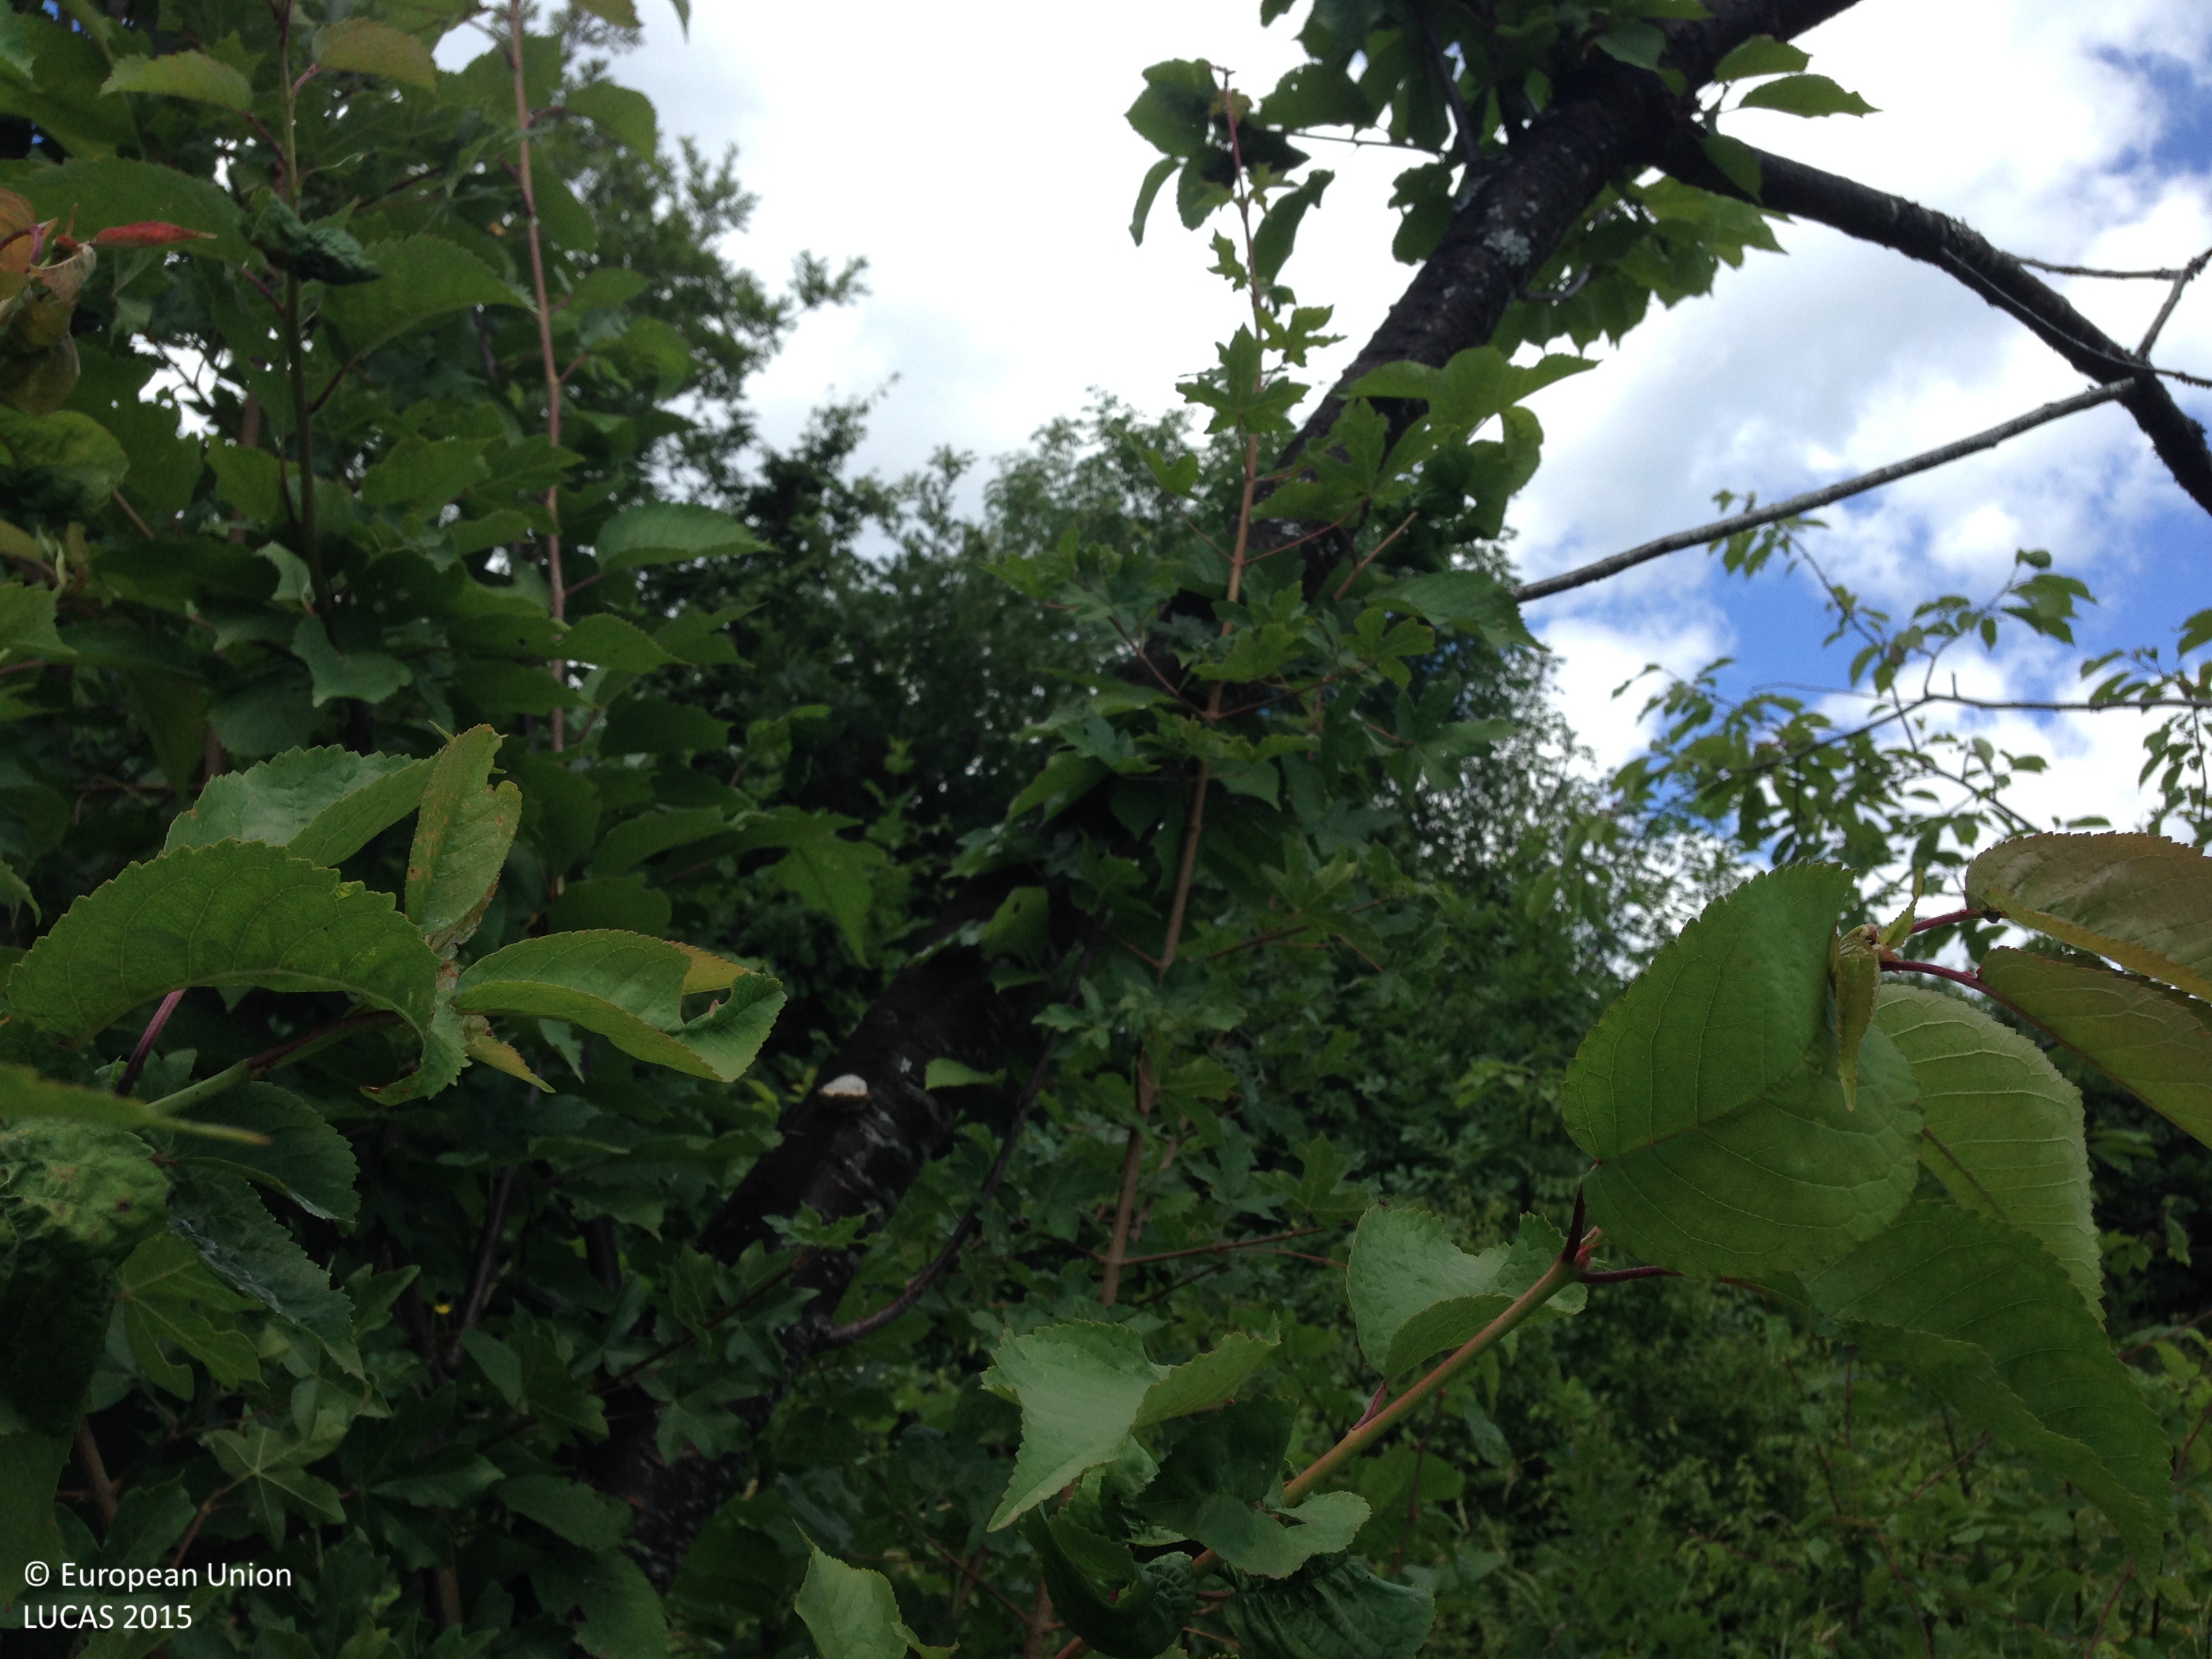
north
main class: Woodland
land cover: Broadleaved woodland
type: thermophilous deciduous forest
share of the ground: 10 - 25 %
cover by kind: herbaceous plants 50 %, shrubs 30 %, broadleaved forest trees 15 %, unconsolidated bare surface 5 %
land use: Semi-natural and natural areas not in use
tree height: < 5 m
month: June
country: HR
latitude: 44.6479
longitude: 15.9836
